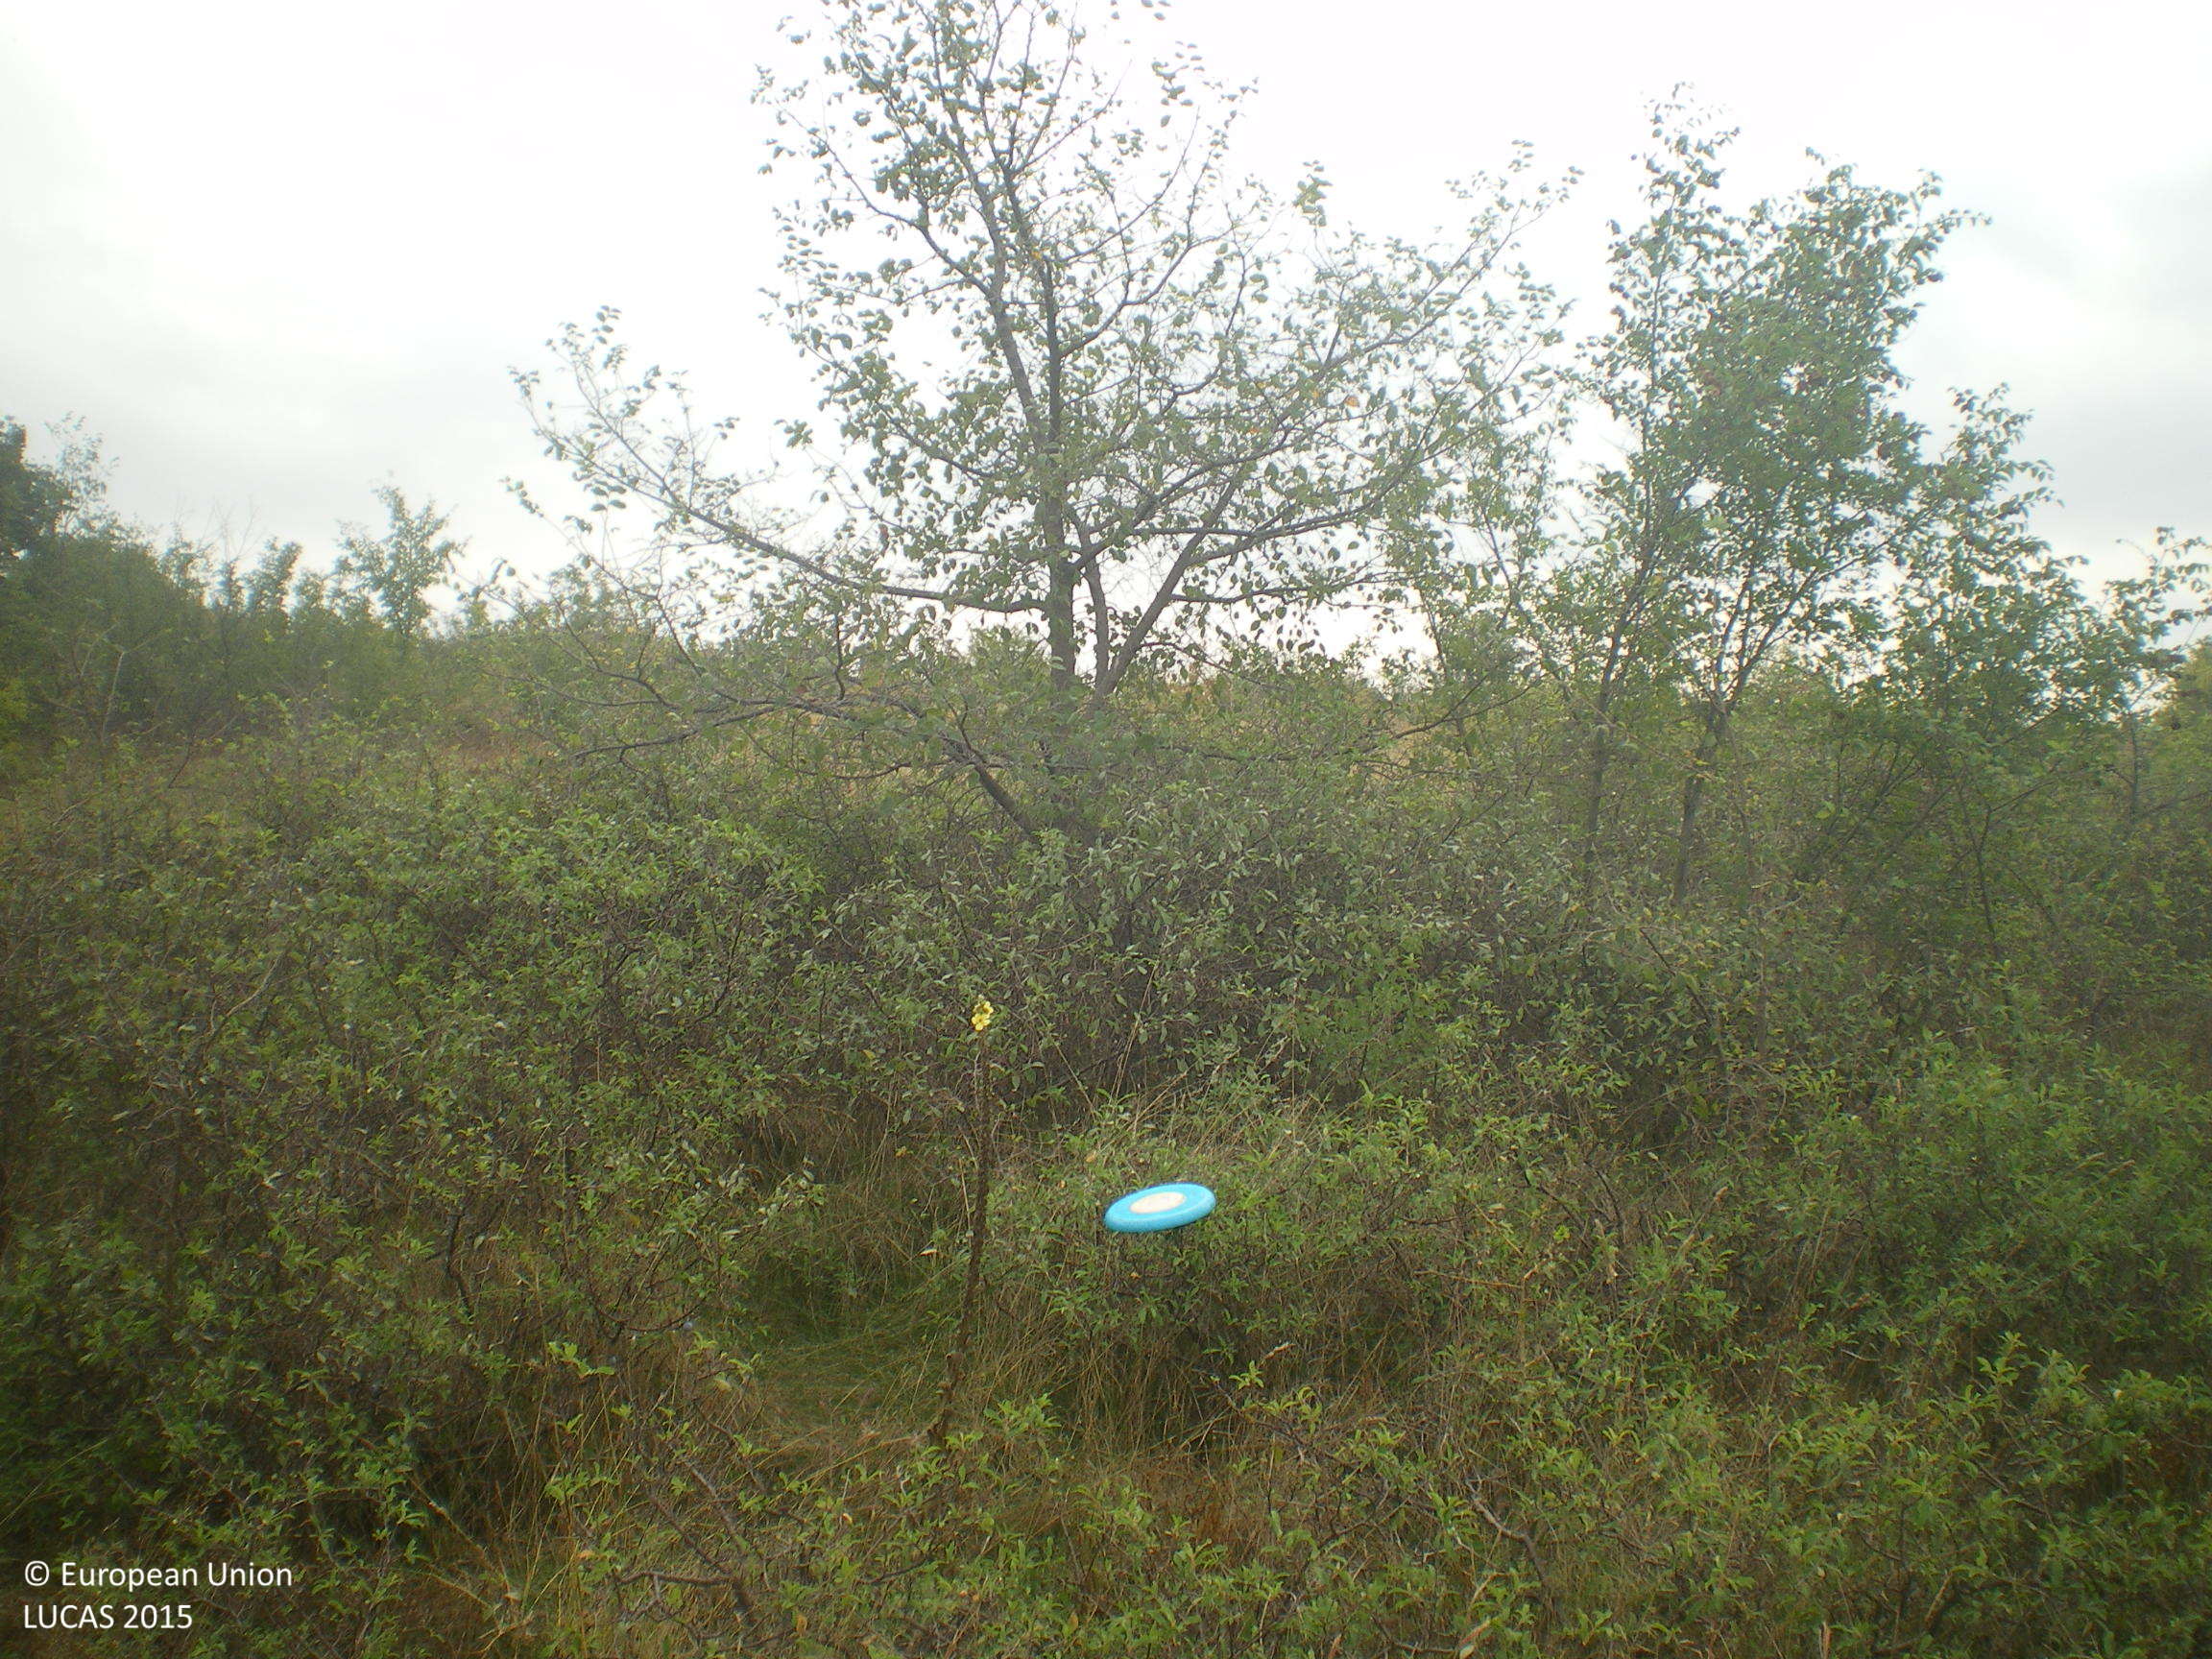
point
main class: Shrubland
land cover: Shrubland with sparse tree cover
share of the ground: > 75 %
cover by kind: shrubs 70 %, herbaceous plants 25 %, broadleaved forest trees 5 %
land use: Semi-natural and natural areas not in use
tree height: > 5 m
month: September
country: BG
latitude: 42.0933
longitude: 25.9740
